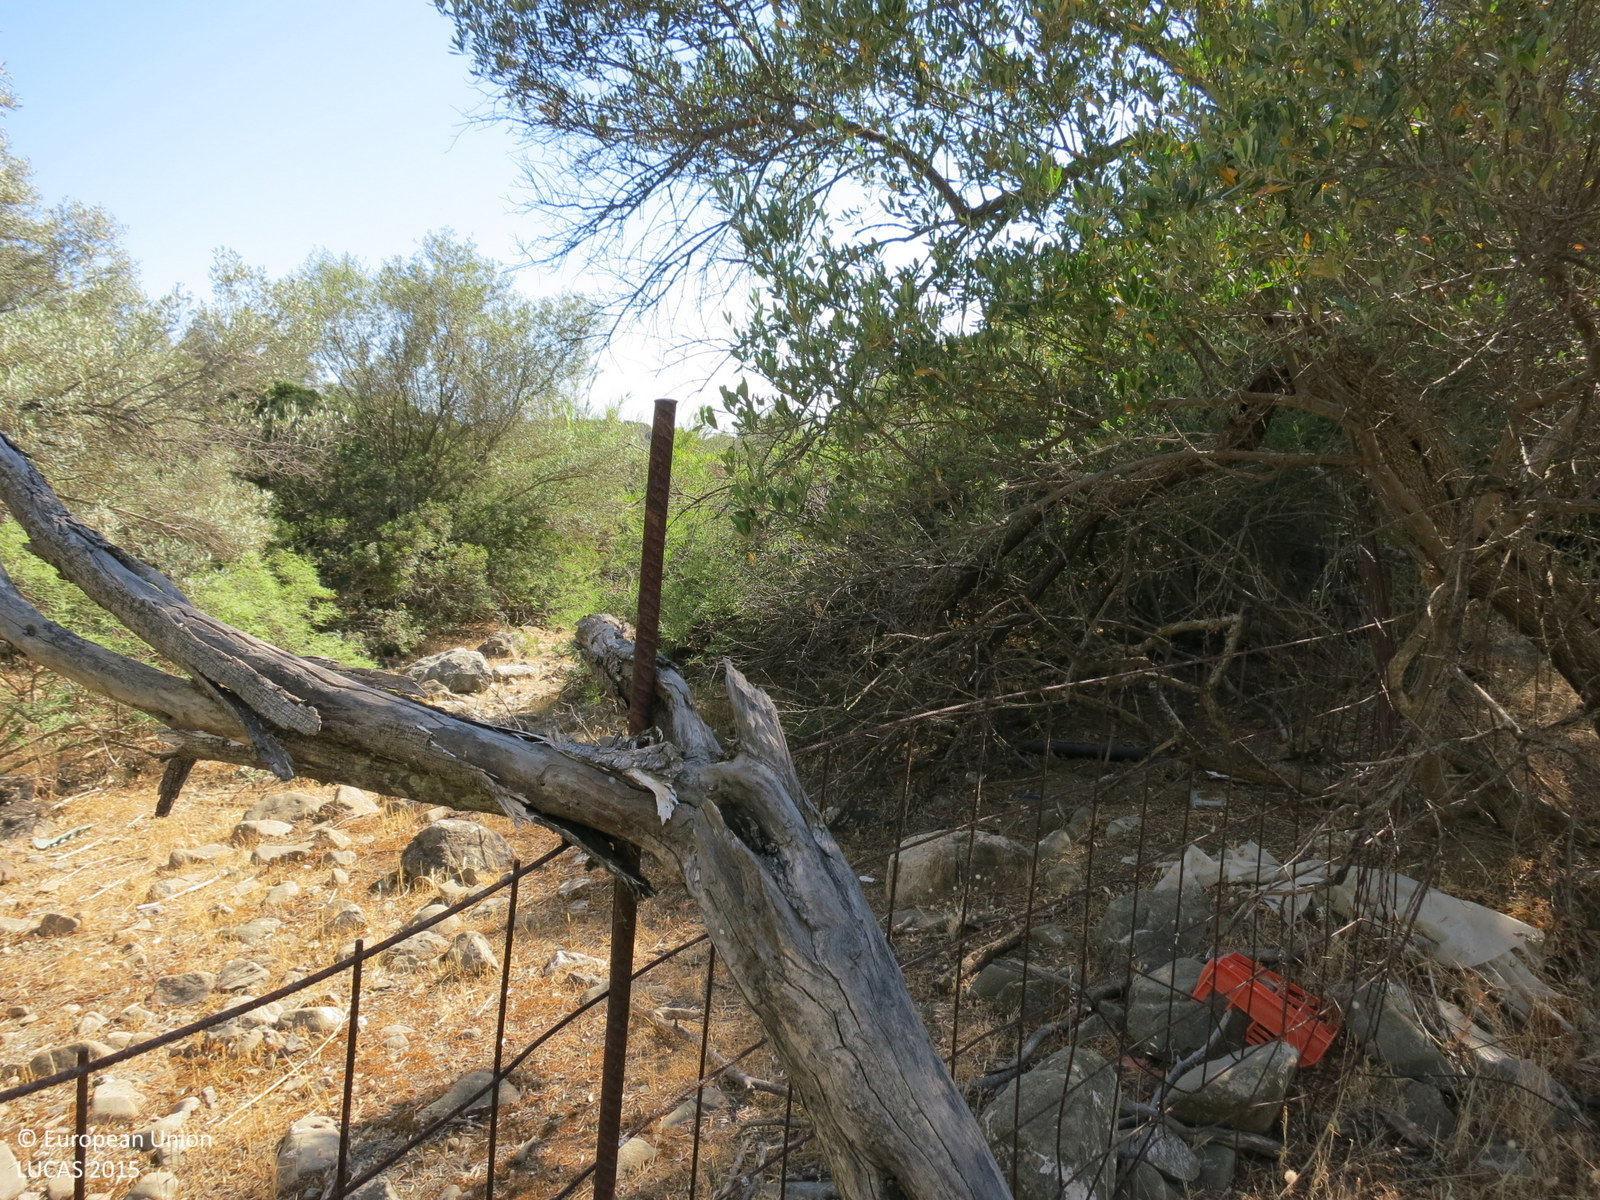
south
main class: Cropland
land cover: Olive groves
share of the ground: 50 - 75 %
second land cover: Shrubland without tree cover
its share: 25 - 50 %
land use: Agriculture (excluding fallow land and kitchen gardens)
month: June
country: GR
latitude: 35.1078
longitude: 24.8073
